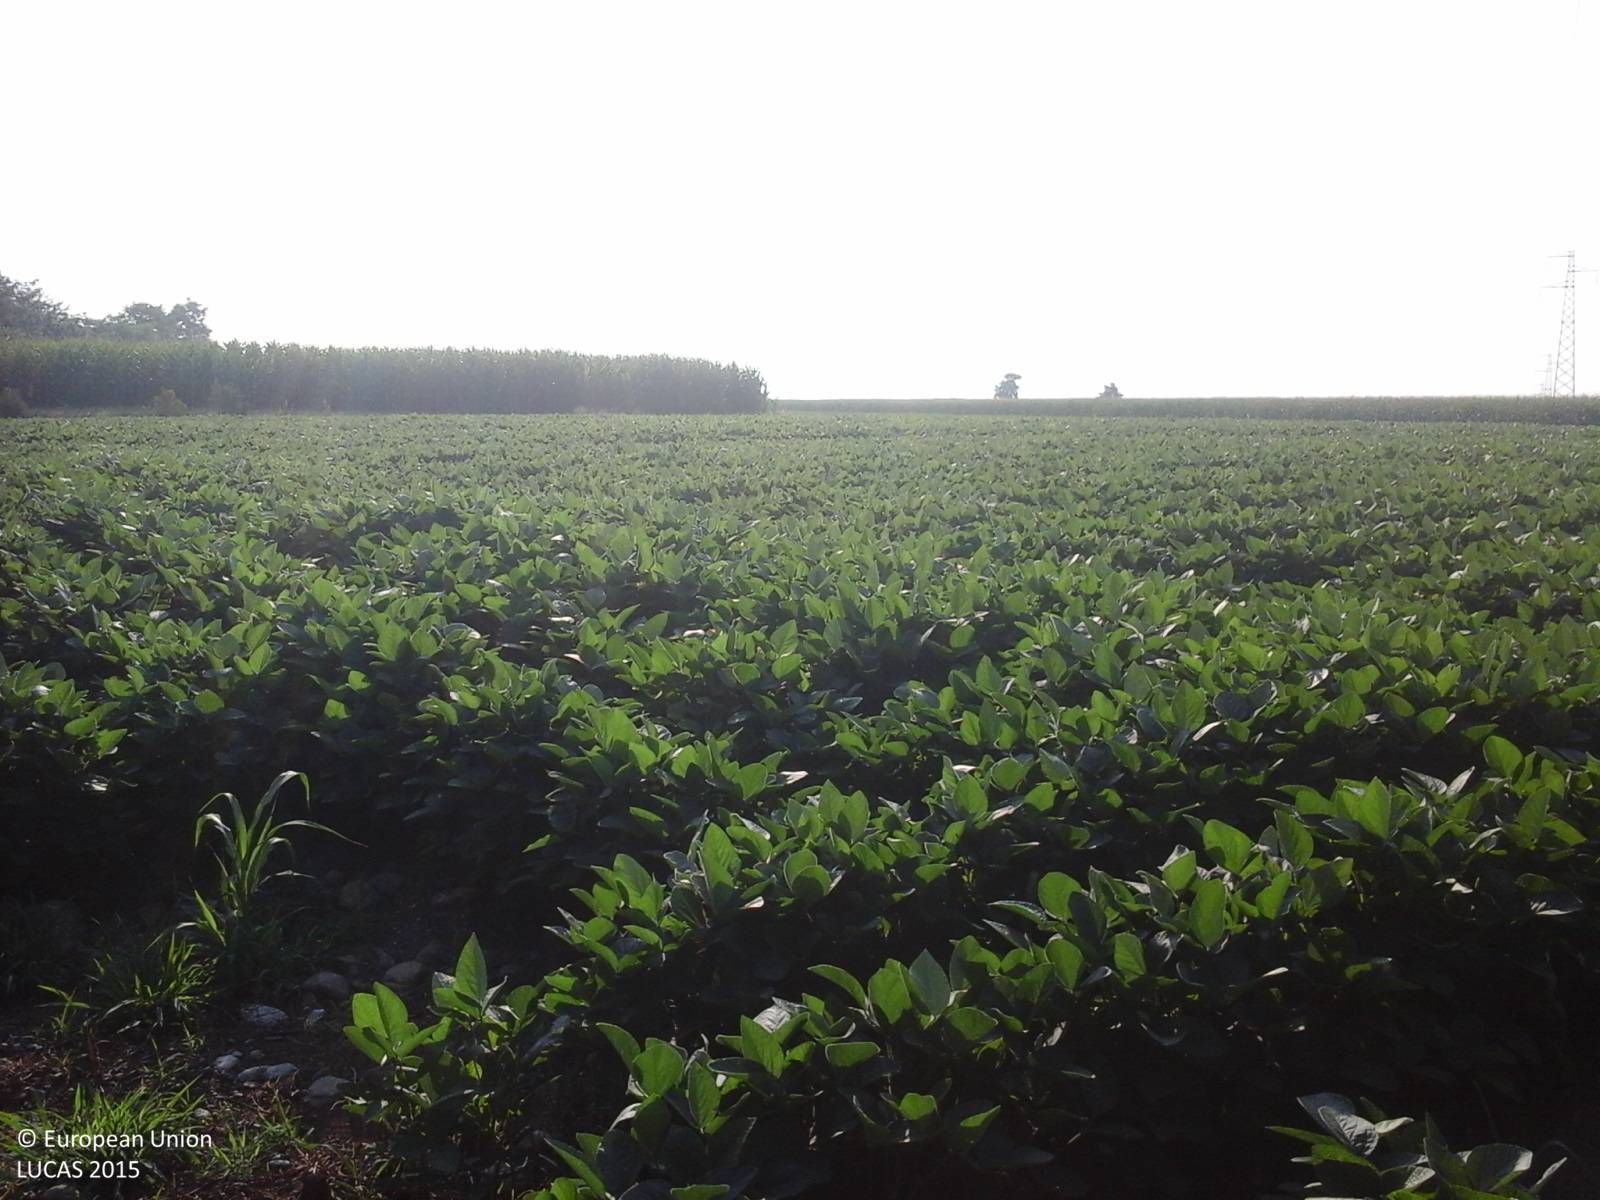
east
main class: Woodland
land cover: Broadleaved woodland
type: thermophilous deciduous forest
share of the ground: > 75 %
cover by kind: broadleaved forest trees 60 %, shrubs 40 %
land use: Forestry
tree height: > 5 m
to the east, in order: Broadleaved woodland; Ditches and canals; Abandoned hedges; Grass margins; Soya; Spontaneously vegetated surfaces; Maize; Lucerne; Grass margins; Paved roads, cycling and walking lanes; Grass margins; Soya
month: July
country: IT
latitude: 46.1091
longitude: 13.0628
